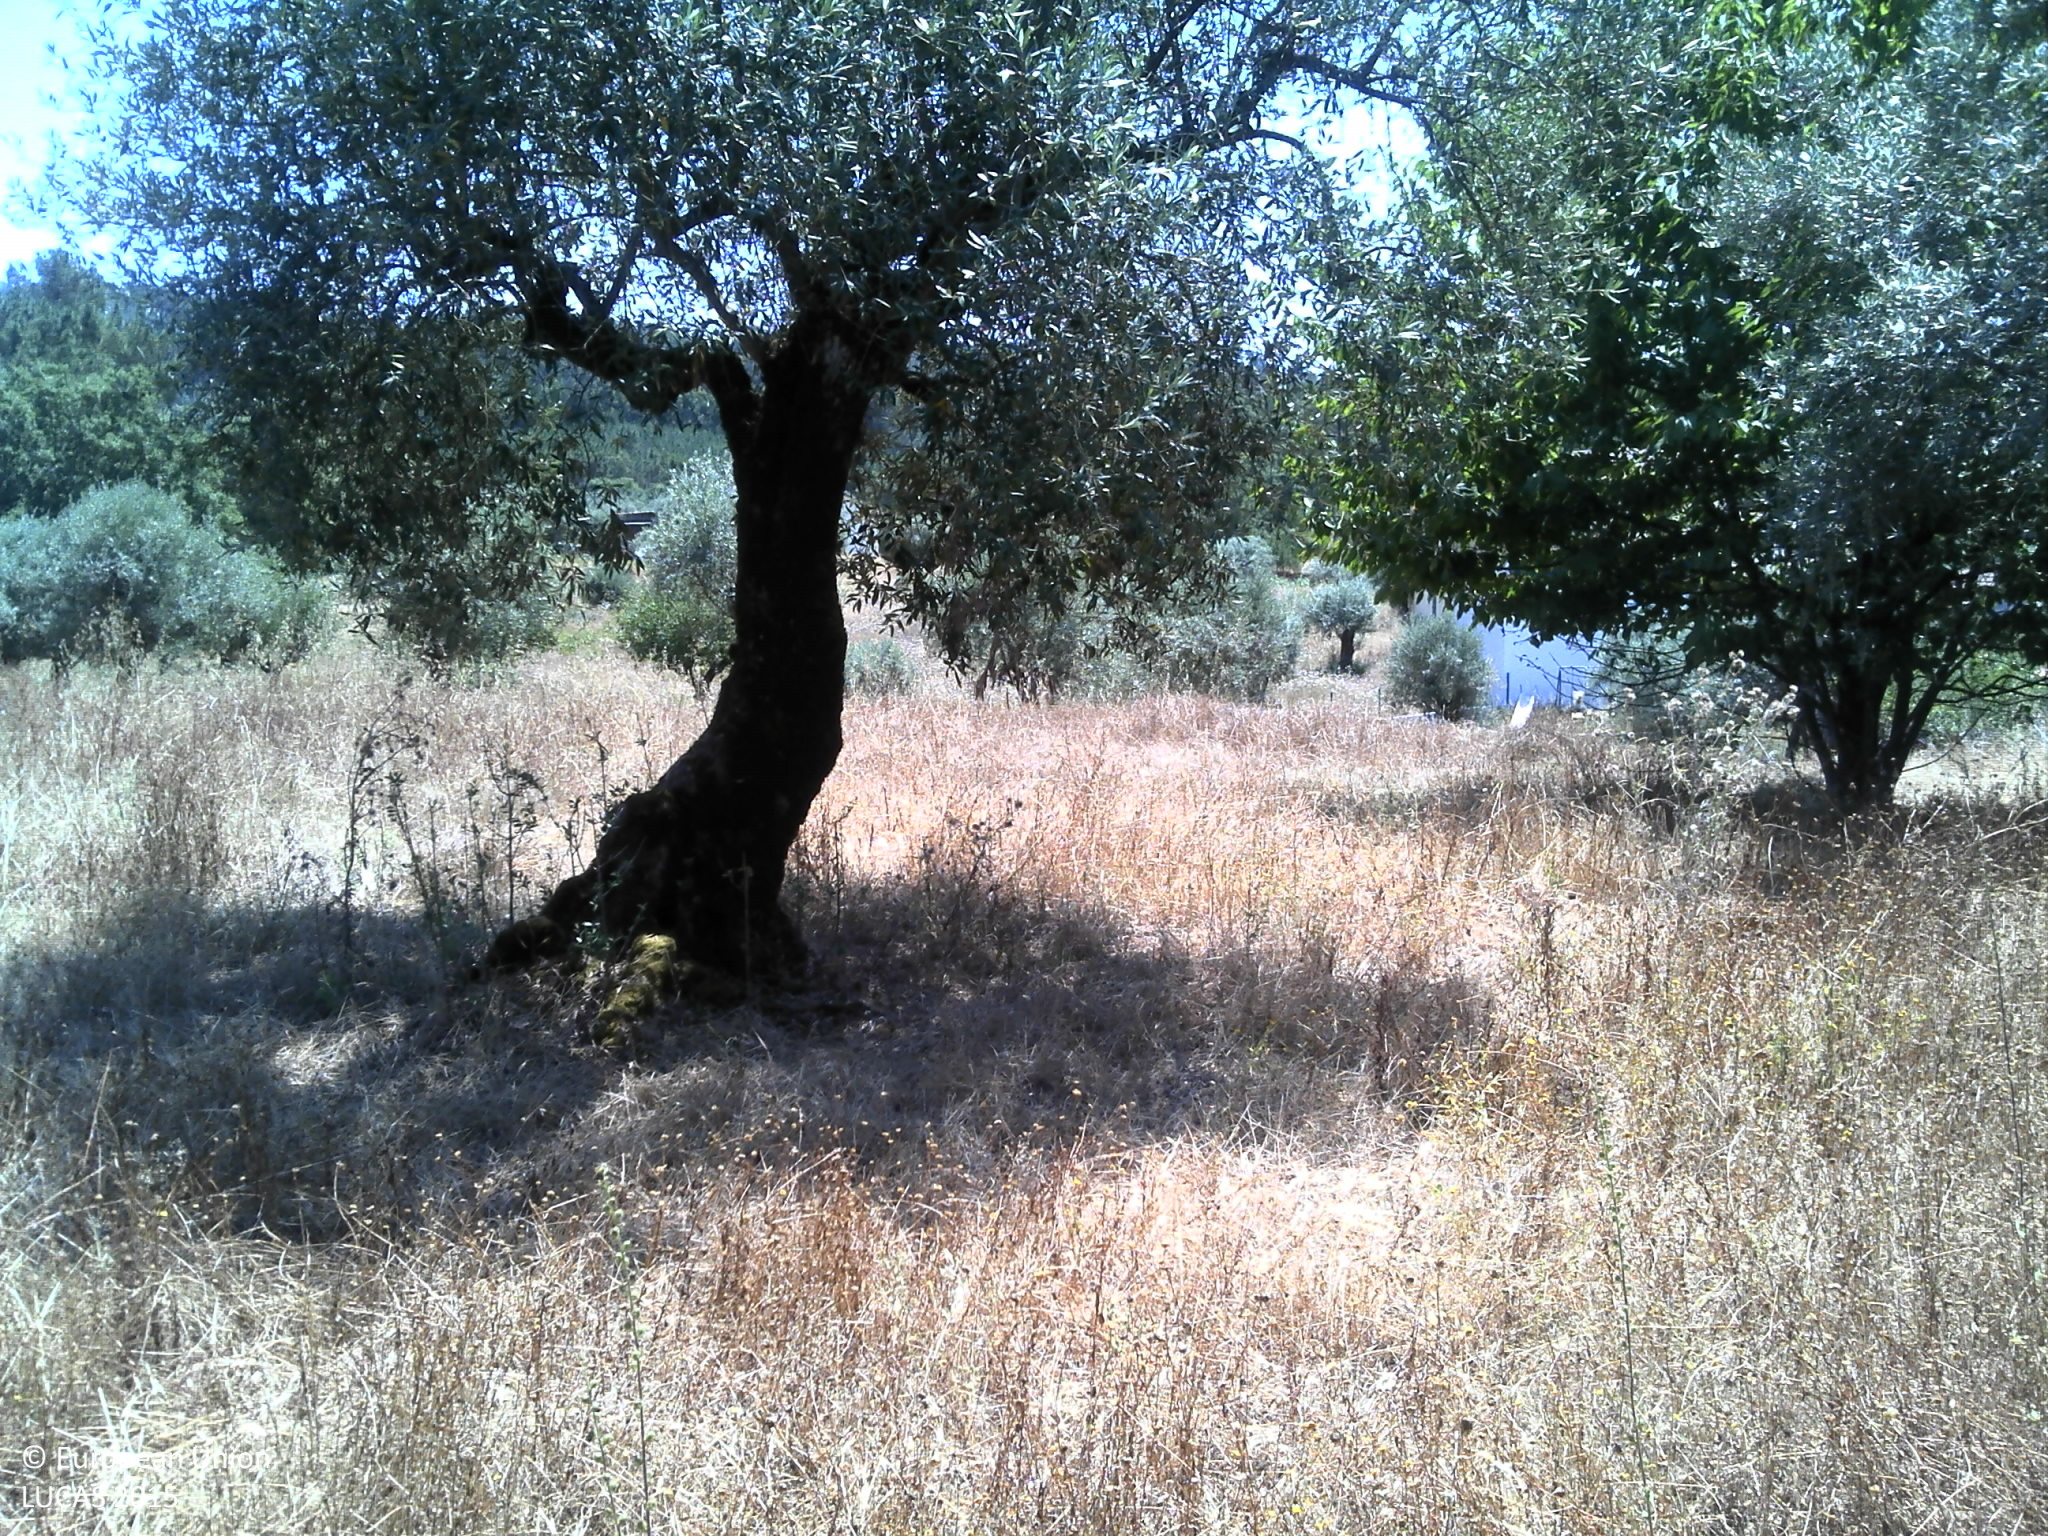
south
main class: Grassland
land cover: Grassland with sparse tree/shrub cover
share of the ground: > 75 %
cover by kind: herbaceous plants 80 %, coniferous forest trees 5 %
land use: Residential
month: July
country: PT
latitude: 39.9534
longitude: -8.5896
